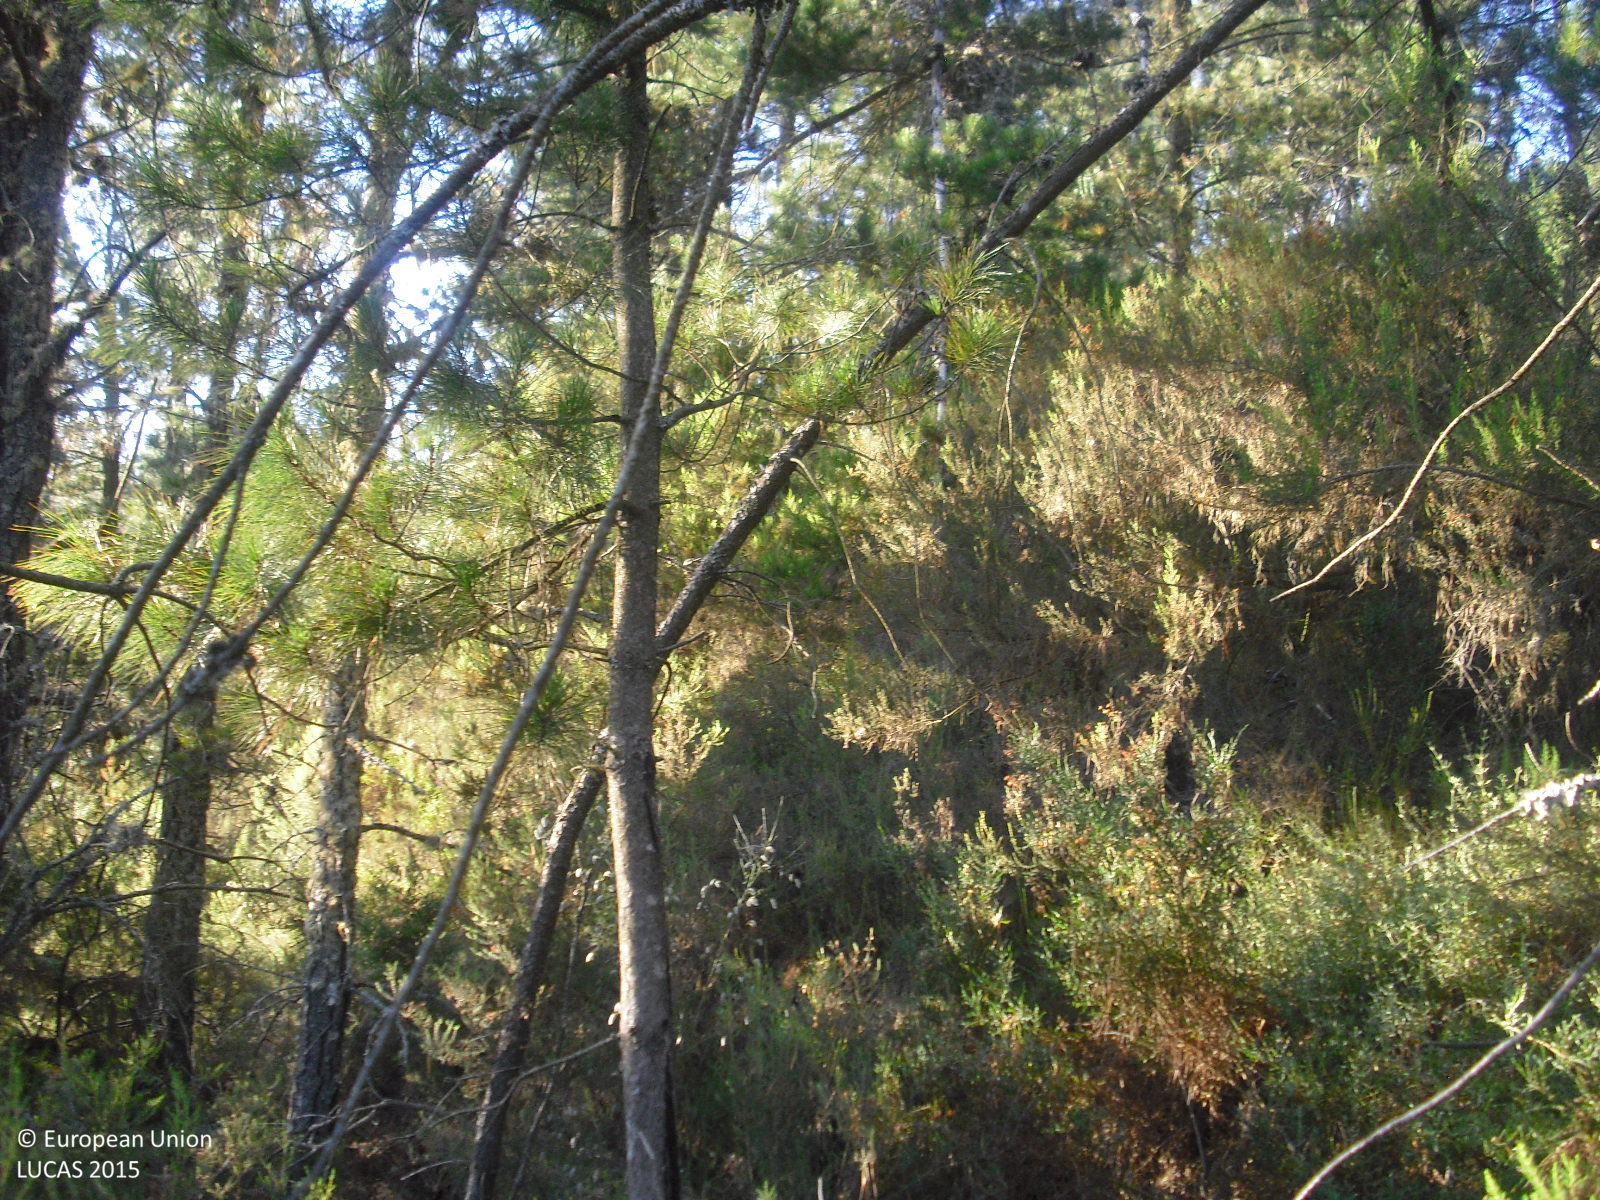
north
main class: Woodland
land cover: Pine dominated coniferous woodland
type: hemiboreal forest and nemoral coniferous forest and mixed broadleaved-coniferous forest
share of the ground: 25 - 50 %
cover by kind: coniferous forest trees 50 %, shrubs 45 %, broadleaved forest trees 5 %
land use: Forestry
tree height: > 5 m
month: July
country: ES
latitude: 42.5920
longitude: -7.2839
